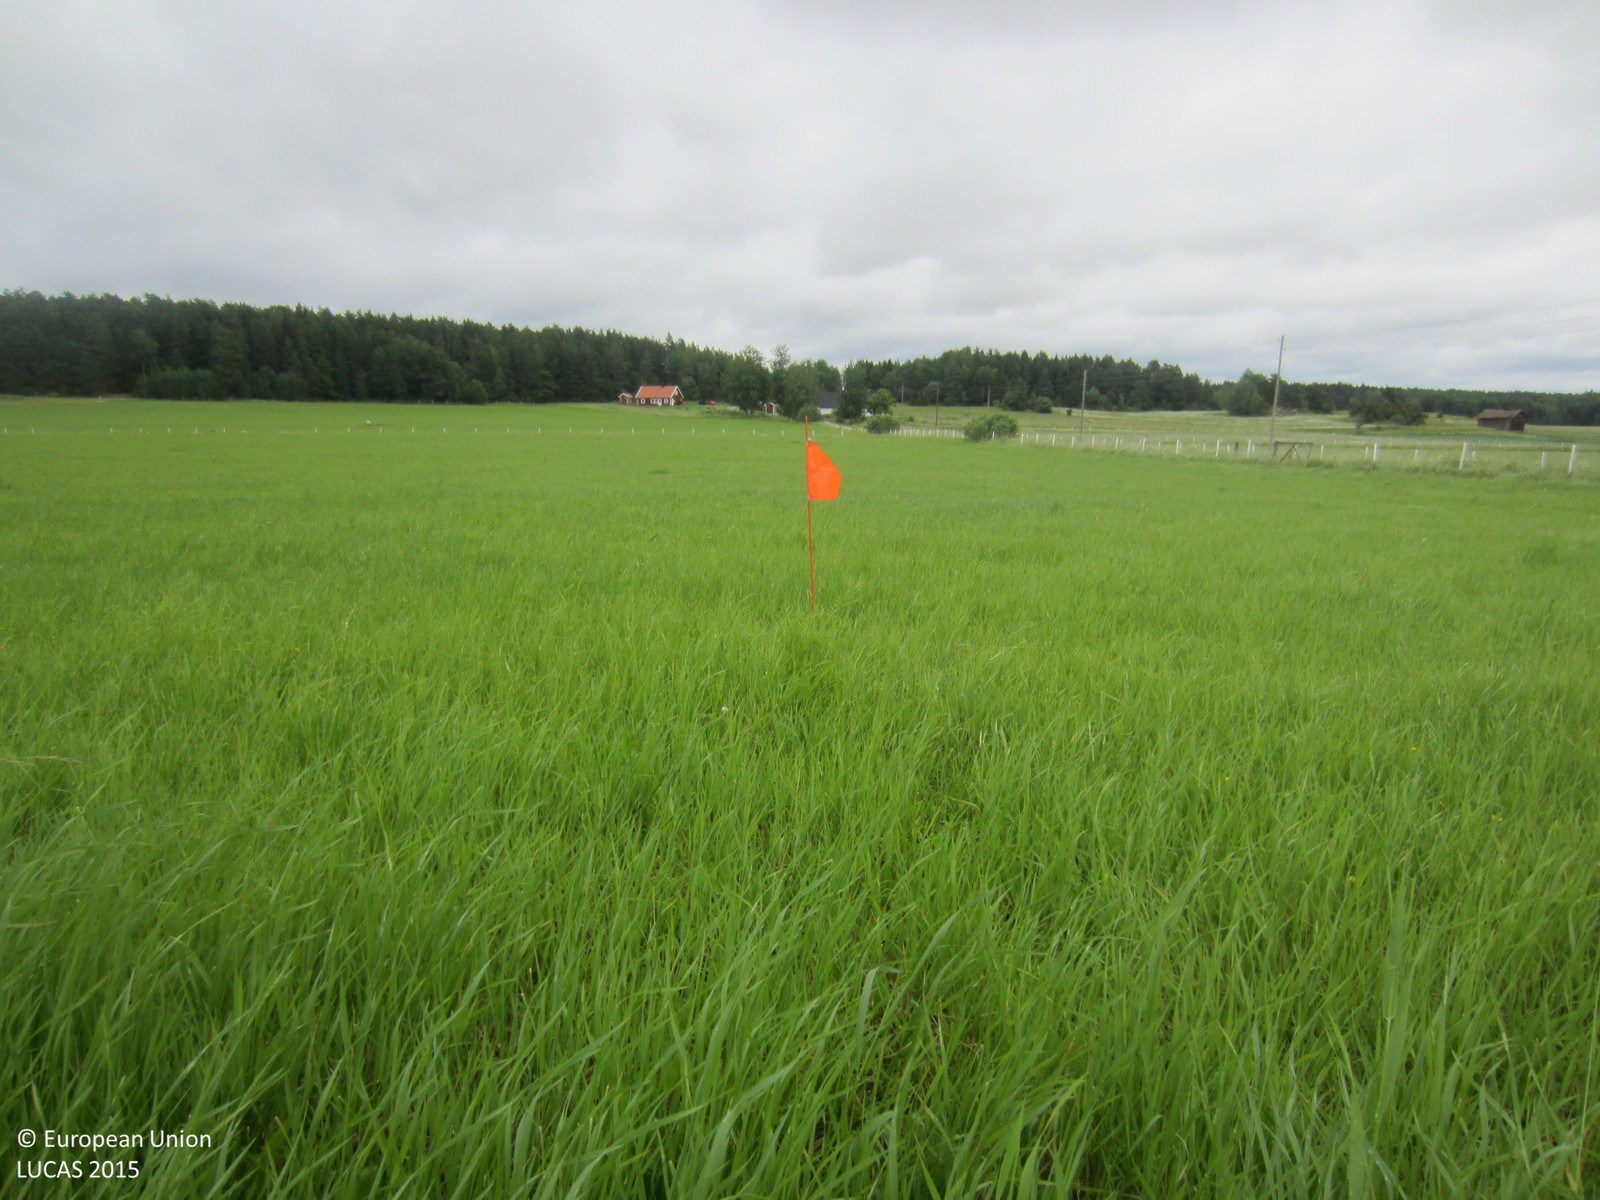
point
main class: Grassland
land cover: Grassland without tree/shrub cover
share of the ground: > 75 %
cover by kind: herbaceous plants 100 %
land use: Agriculture (excluding fallow land and kitchen gardens)
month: July
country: SE
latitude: 59.8009
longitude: 17.1400
